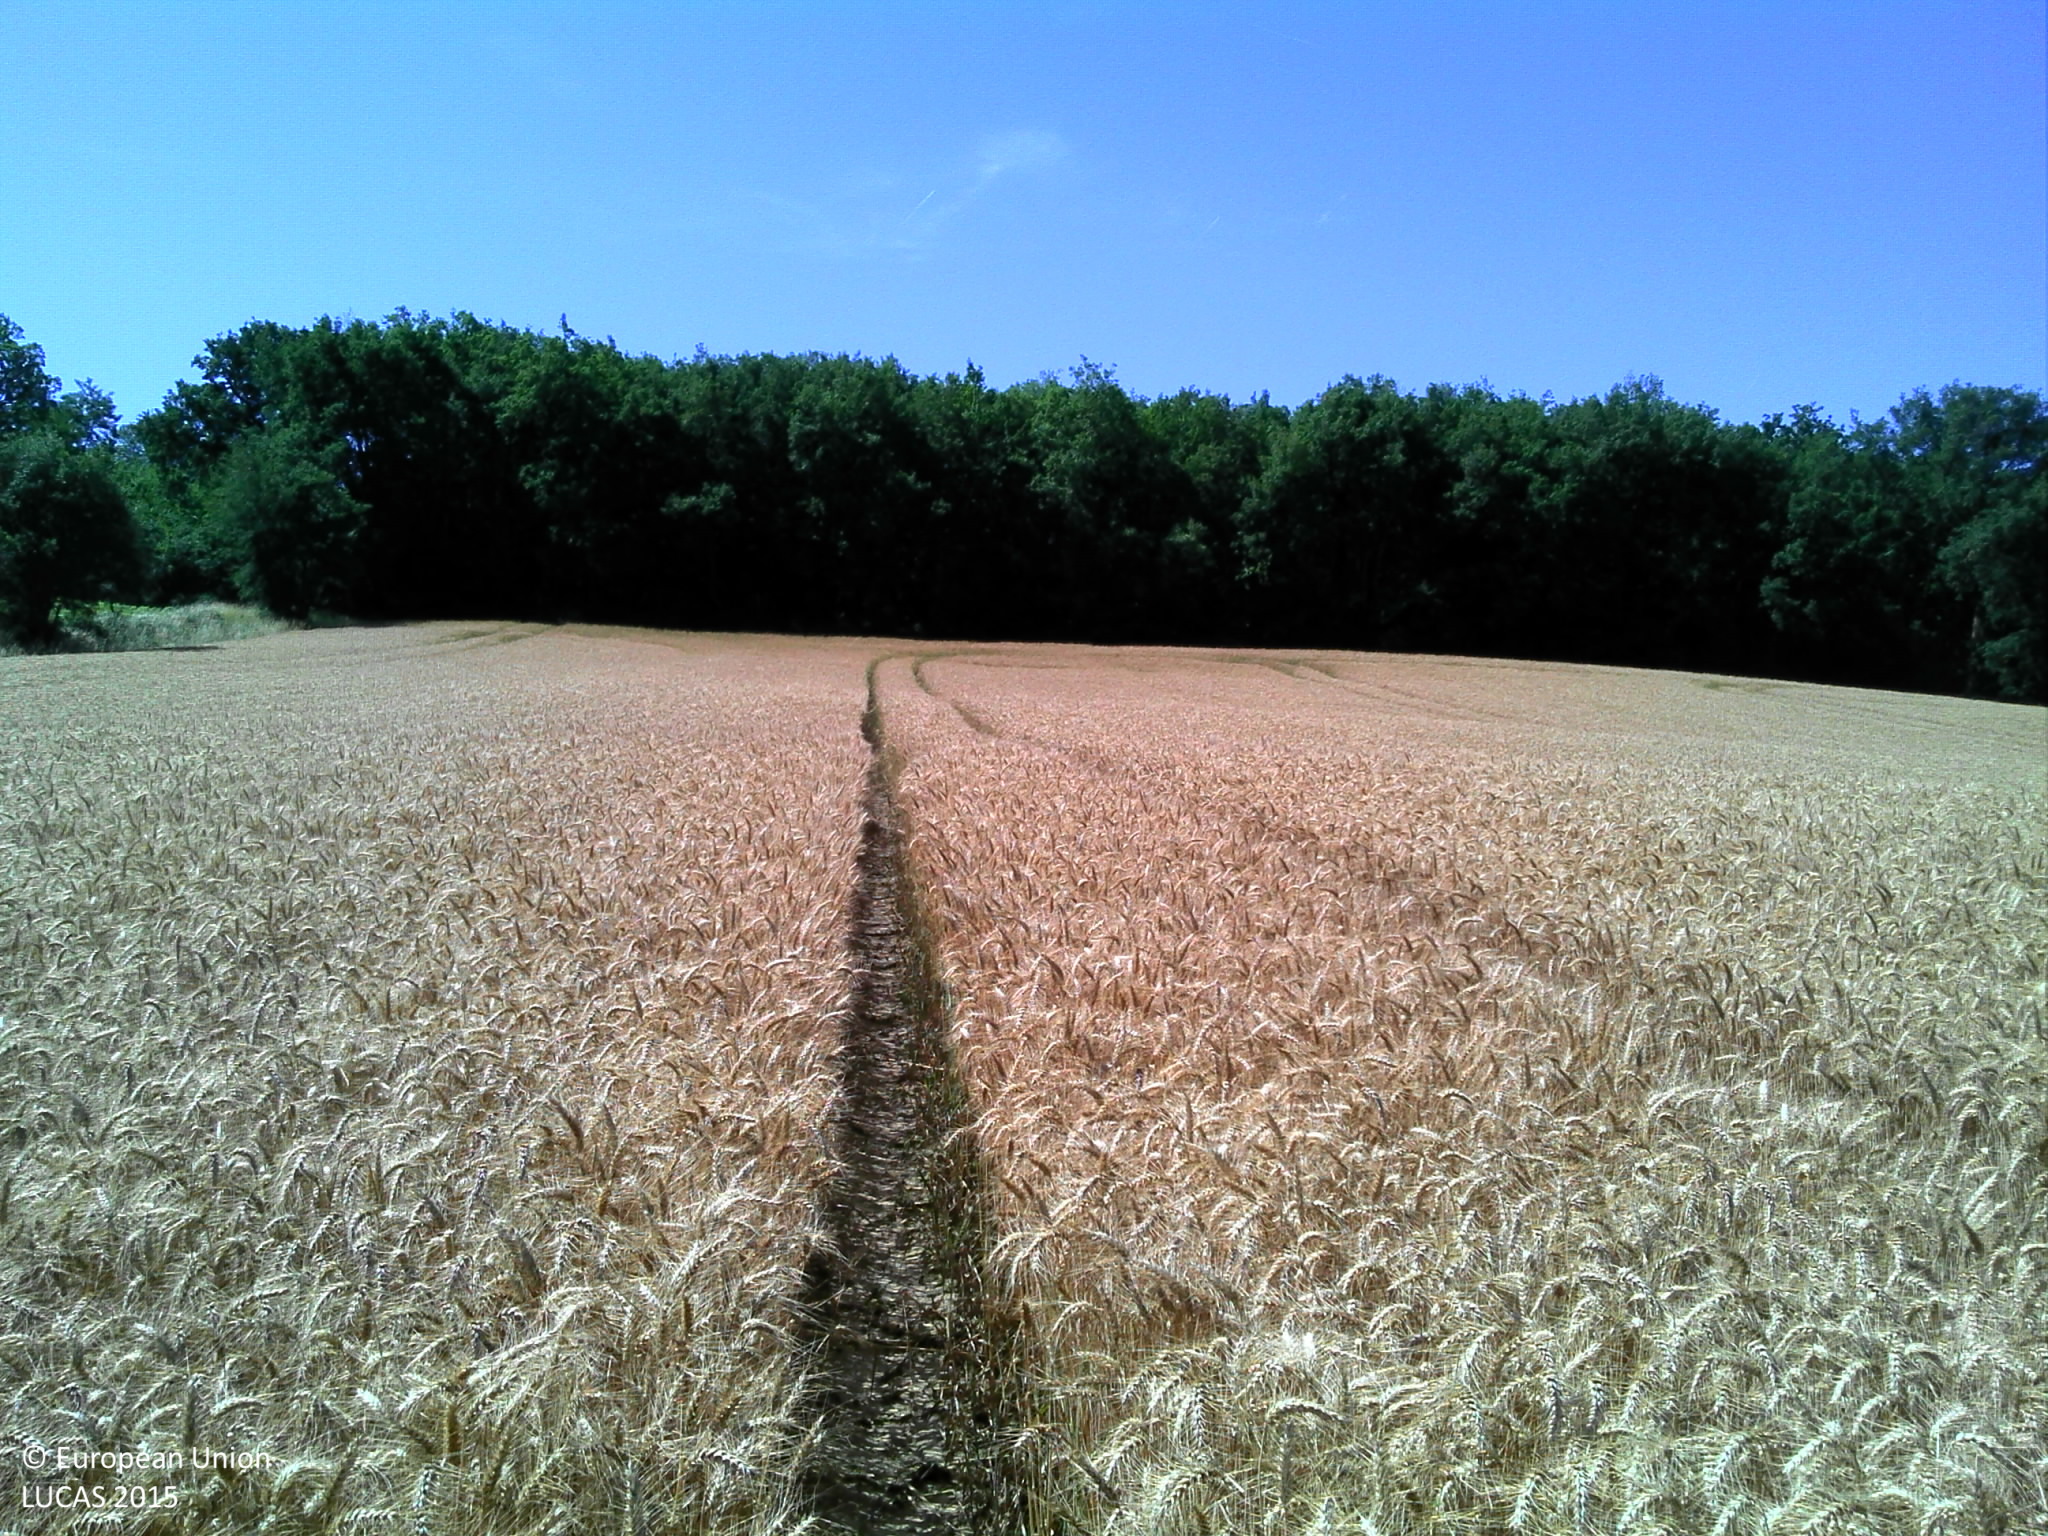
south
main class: Cropland
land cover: Common wheat
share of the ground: > 75 %
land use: Agriculture (excluding fallow land and kitchen gardens)
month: June
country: FR
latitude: 43.7788
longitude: 1.0163
